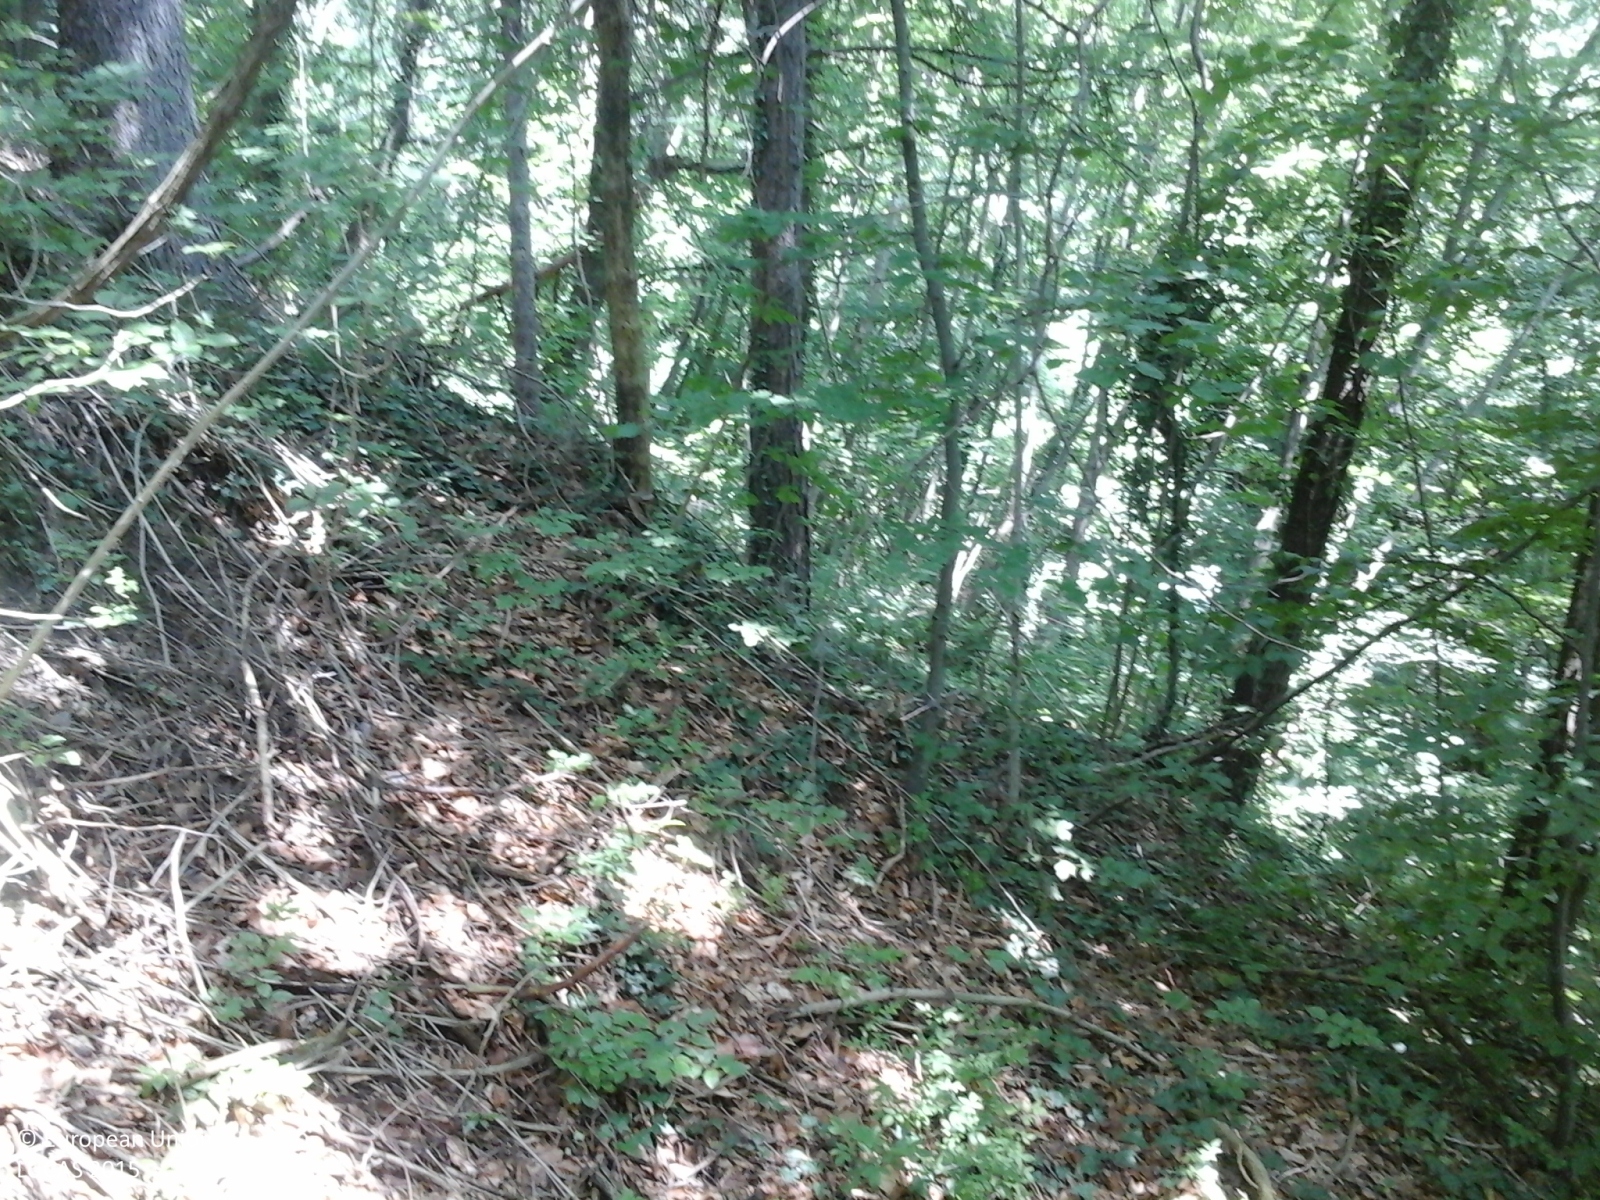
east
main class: Woodland
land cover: Broadleaved woodland
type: thermophilous deciduous forest
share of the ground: > 75 %
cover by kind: broadleaved forest trees 100 %
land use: Forestry
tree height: > 5 m
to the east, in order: Broadleaved woodland; Tracks; Broadleaved woodland; Grassland with sparse tree/shrub cover; Broadleaved woodland
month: July
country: IT
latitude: 45.5878
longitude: 11.1901
